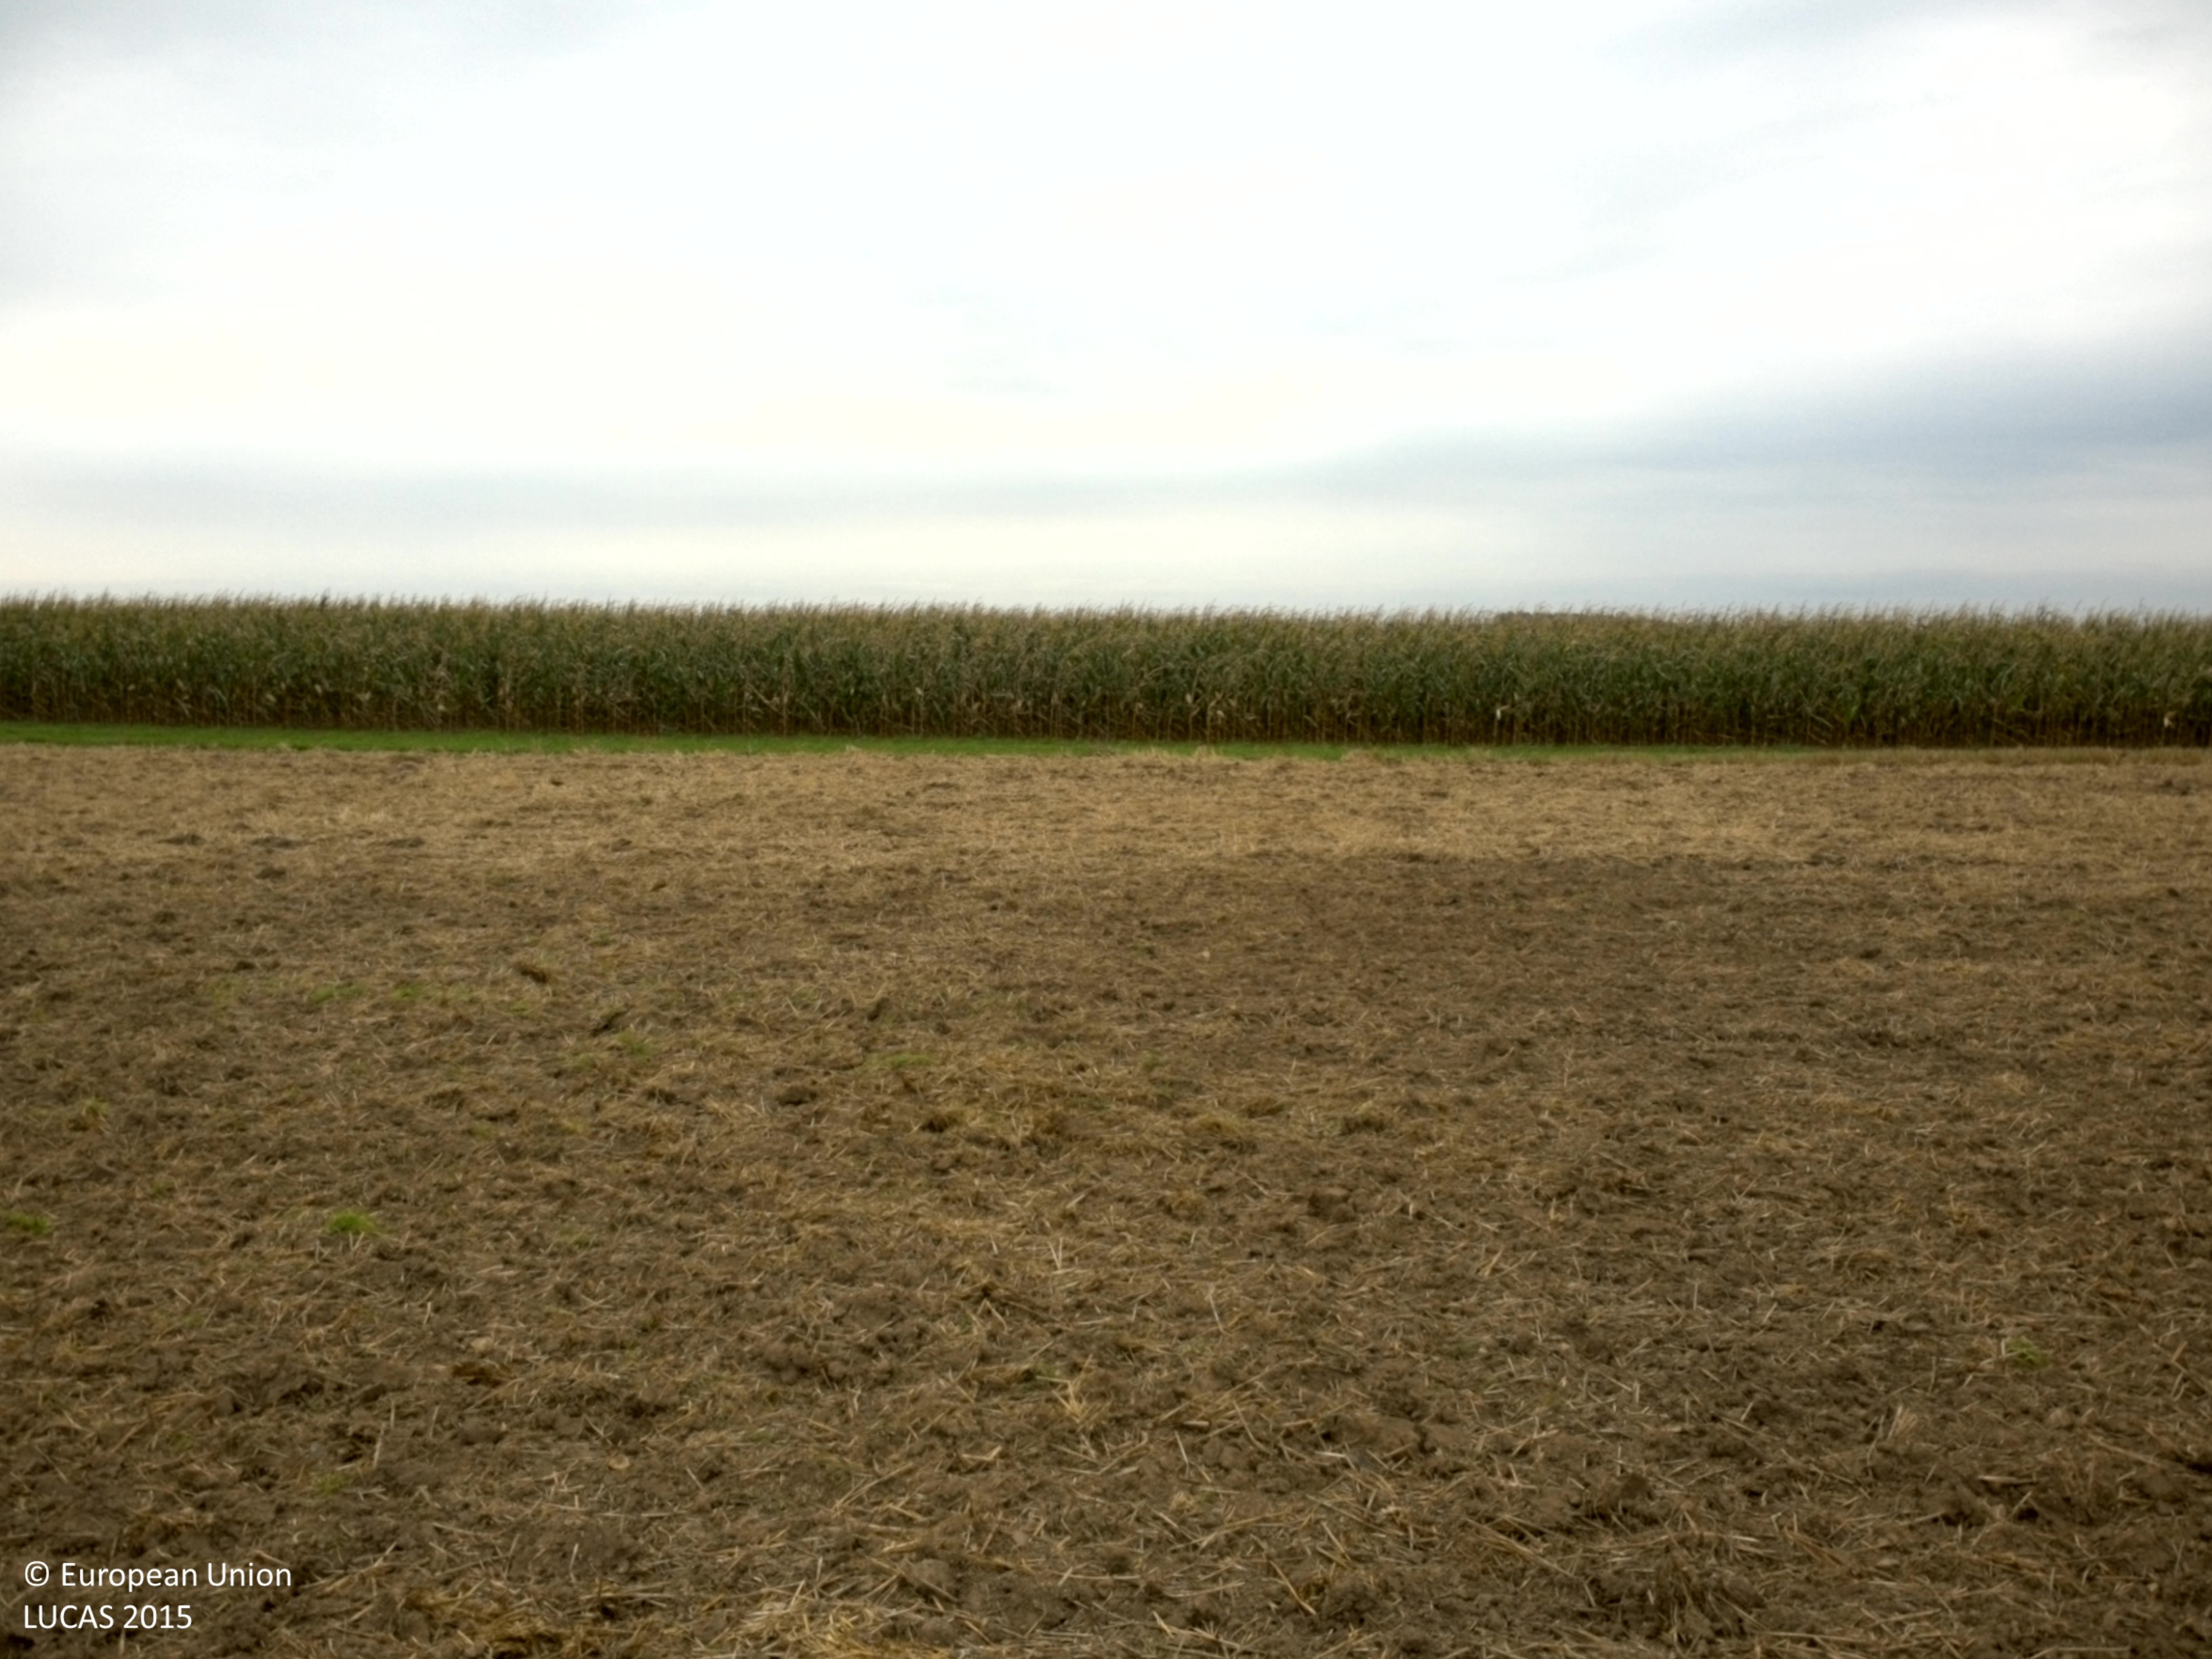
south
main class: Cropland
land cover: Common wheat
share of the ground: < 10 %
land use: Agriculture (excluding fallow land and kitchen gardens)
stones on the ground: < 10 %
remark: Harvested field
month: October
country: SE
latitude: 55.8278
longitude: 13.0469
